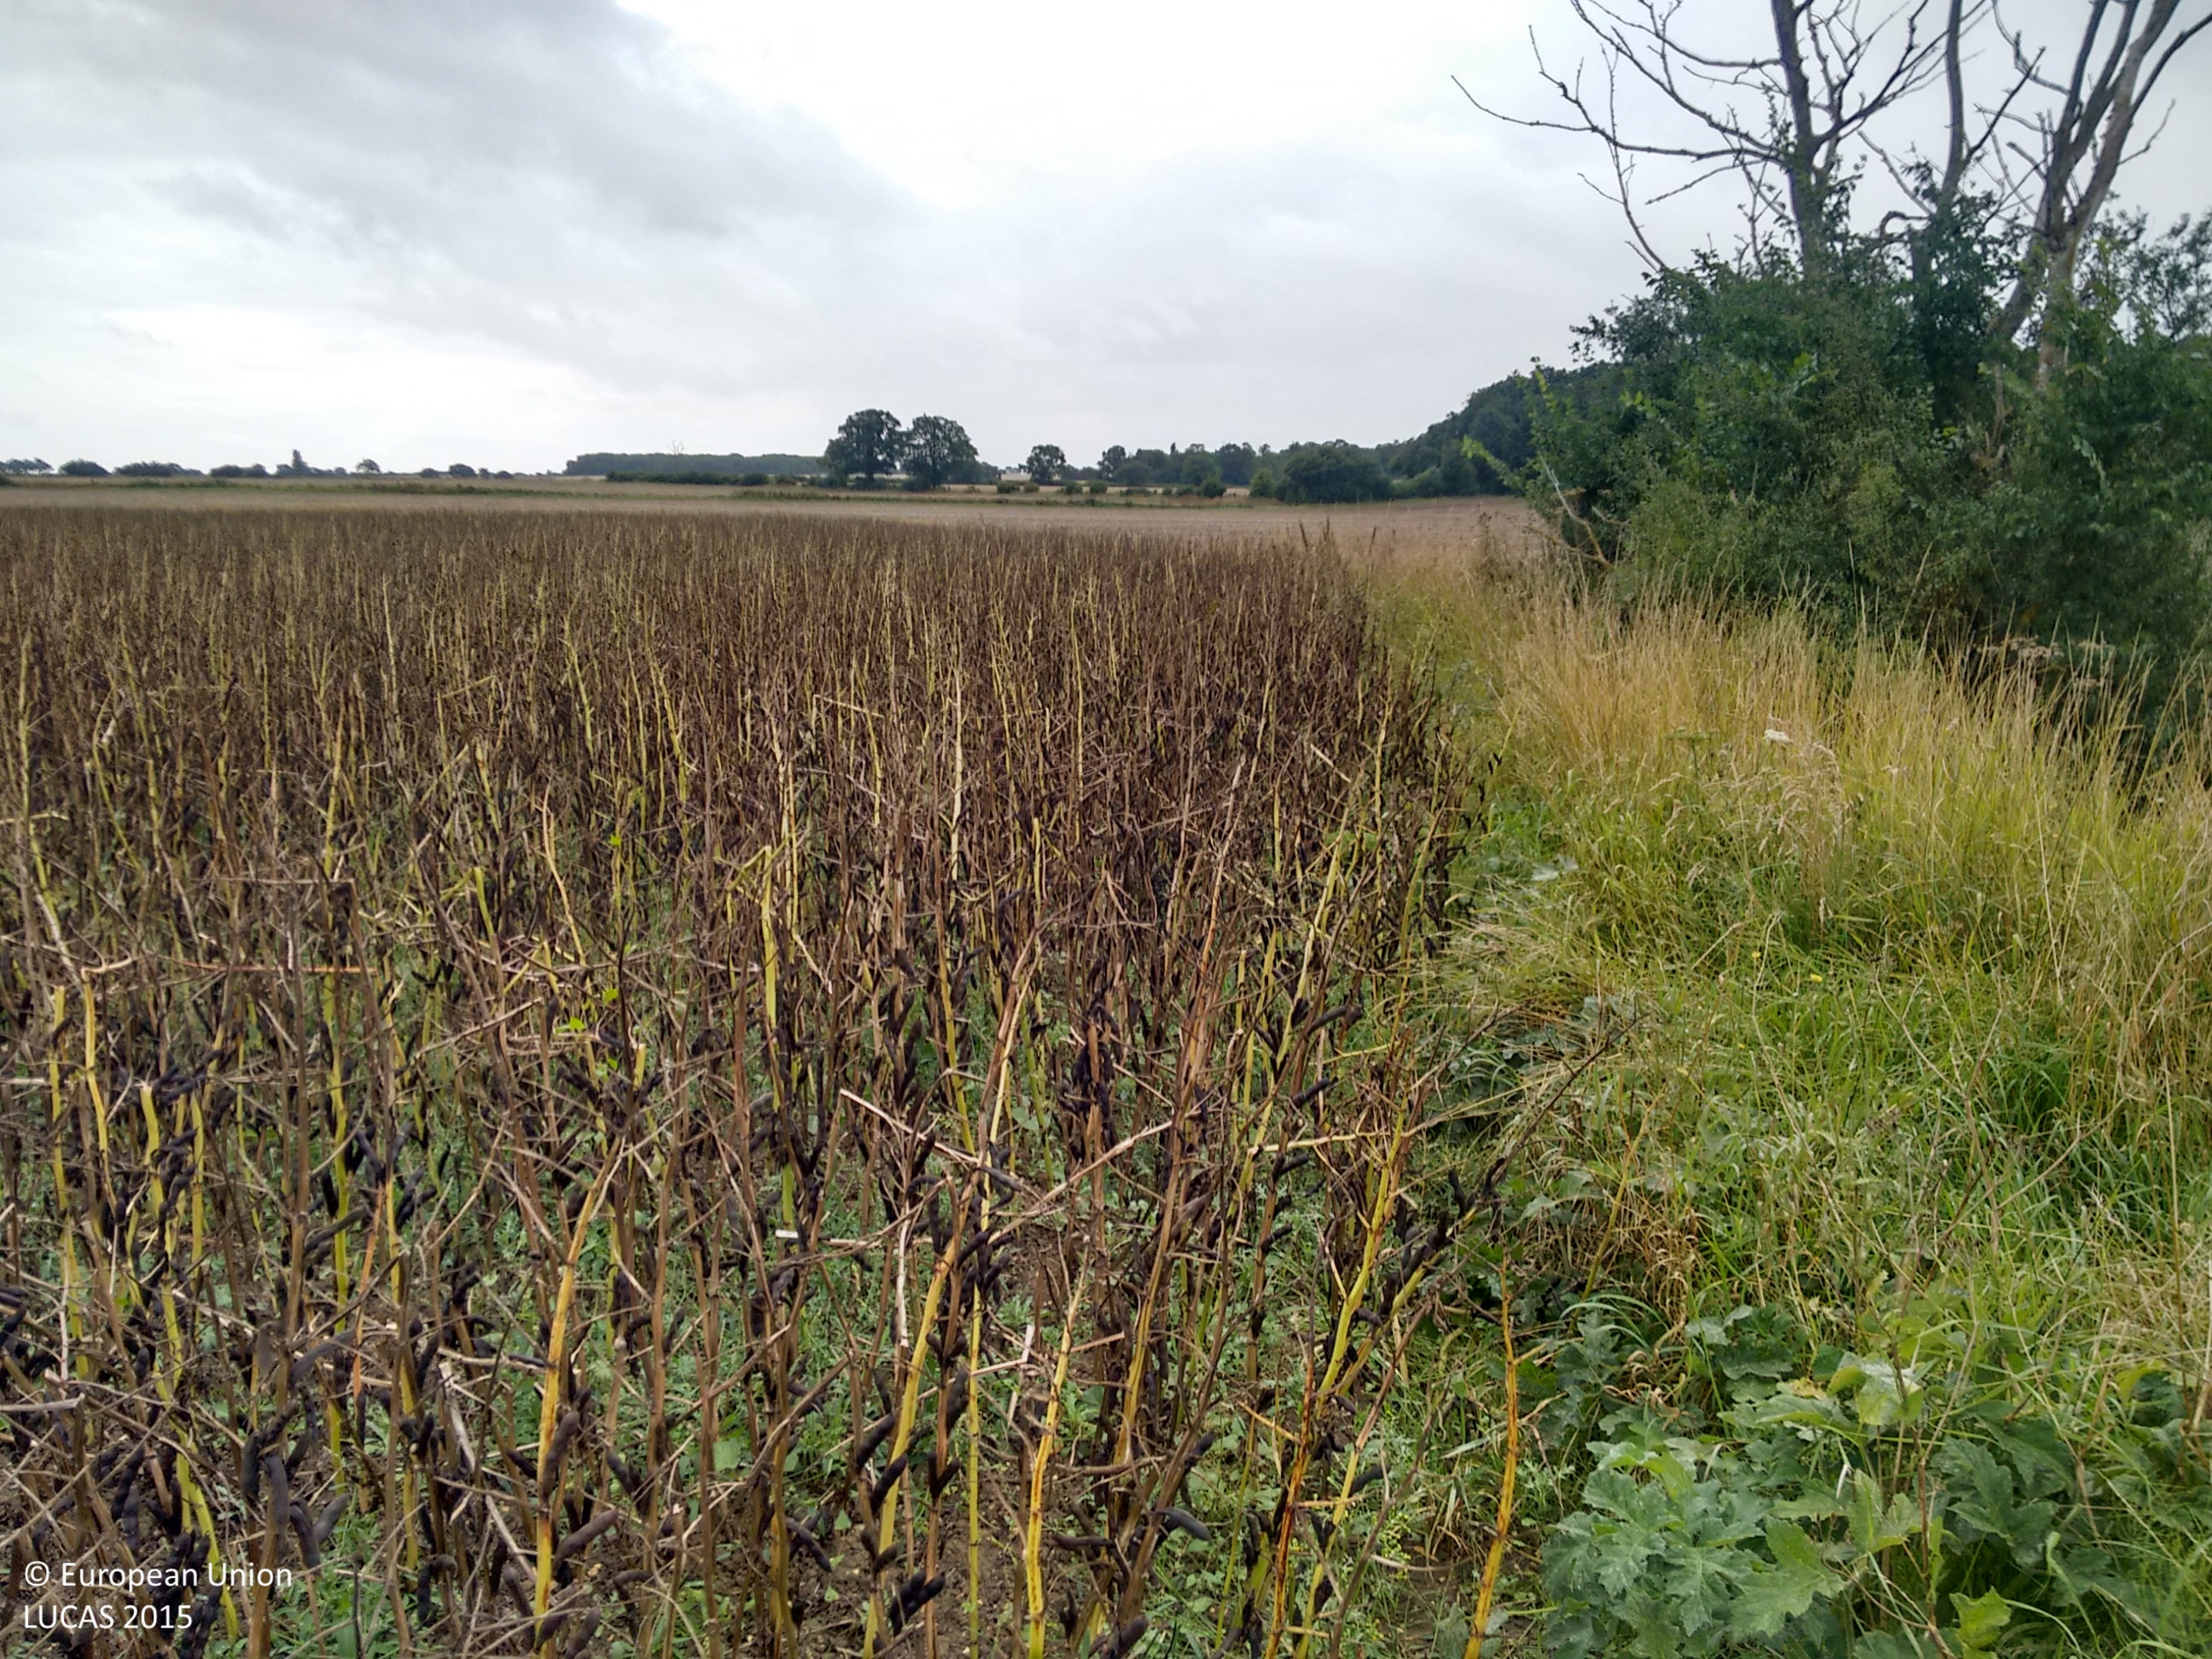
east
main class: Cropland
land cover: Dry pulses
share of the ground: > 75 %
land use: Agriculture (excluding fallow land and kitchen gardens)
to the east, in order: Dry pulses; Grass margins; Ditches and canals; Grass margins; Other bare soil; Grass margins; Tracks; Grass margins; Ditches and canals; Grass margins; Other bare soil
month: August
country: GB
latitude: 52.0863
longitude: 0.5008
